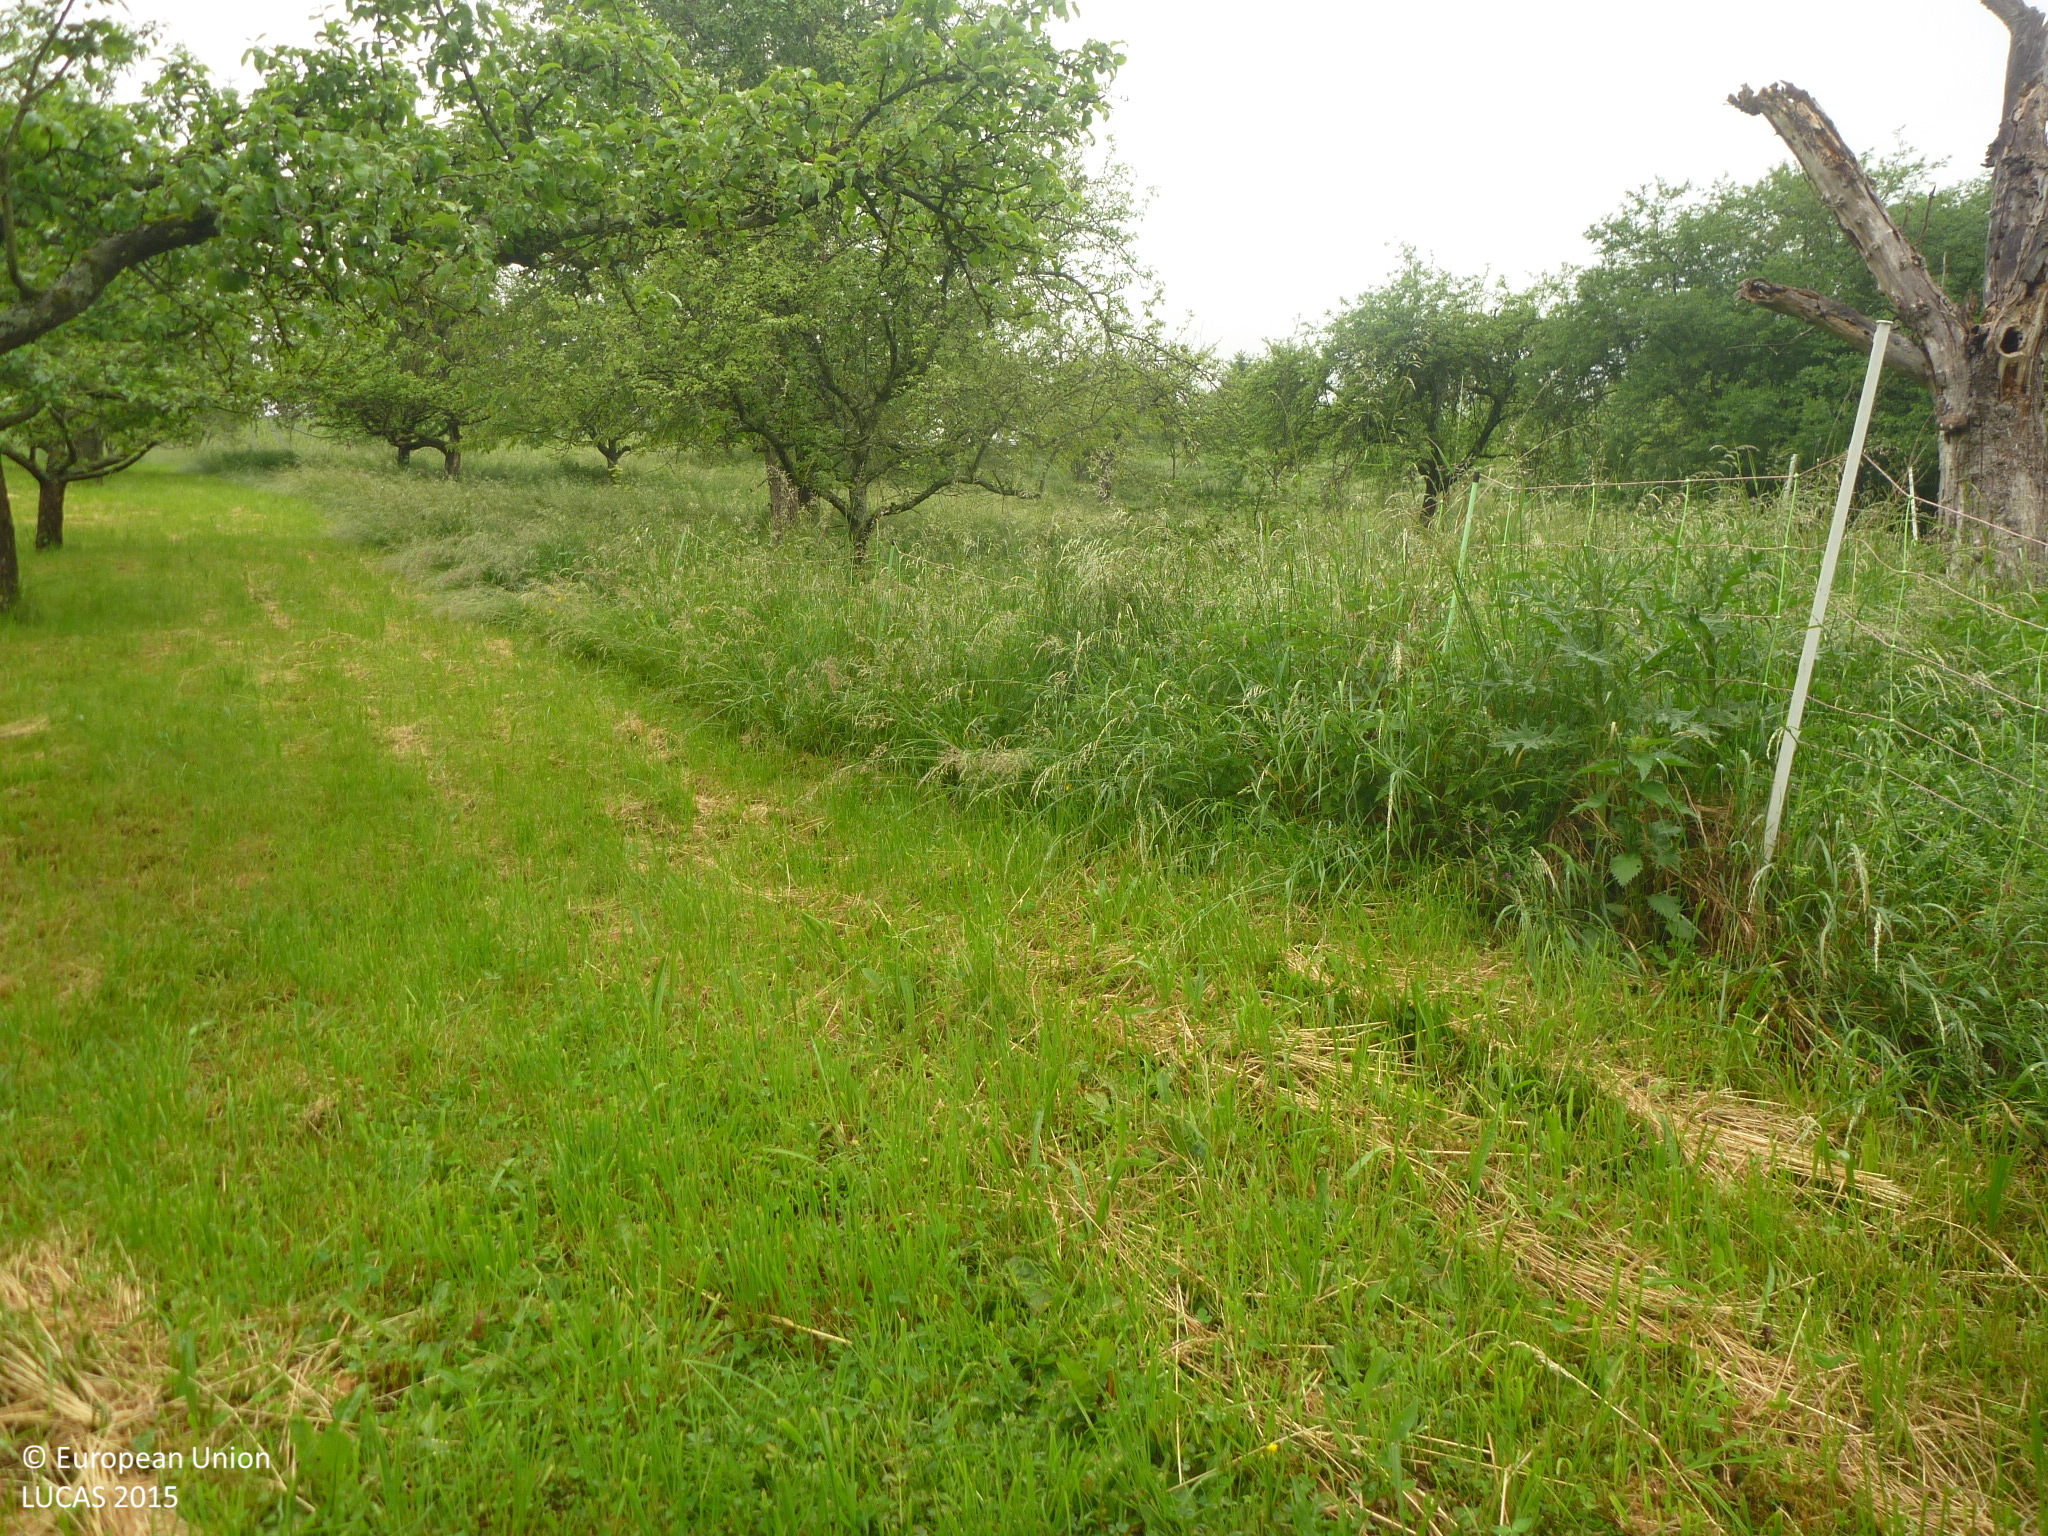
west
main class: Cropland
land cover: Apple fruit
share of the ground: 50 - 75 %
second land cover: Grassland without tree/shrub cover
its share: > 75 %
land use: Agriculture (excluding fallow land and kitchen gardens)
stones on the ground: < 10 %
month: May
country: DE
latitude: 48.7793
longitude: 9.3335
